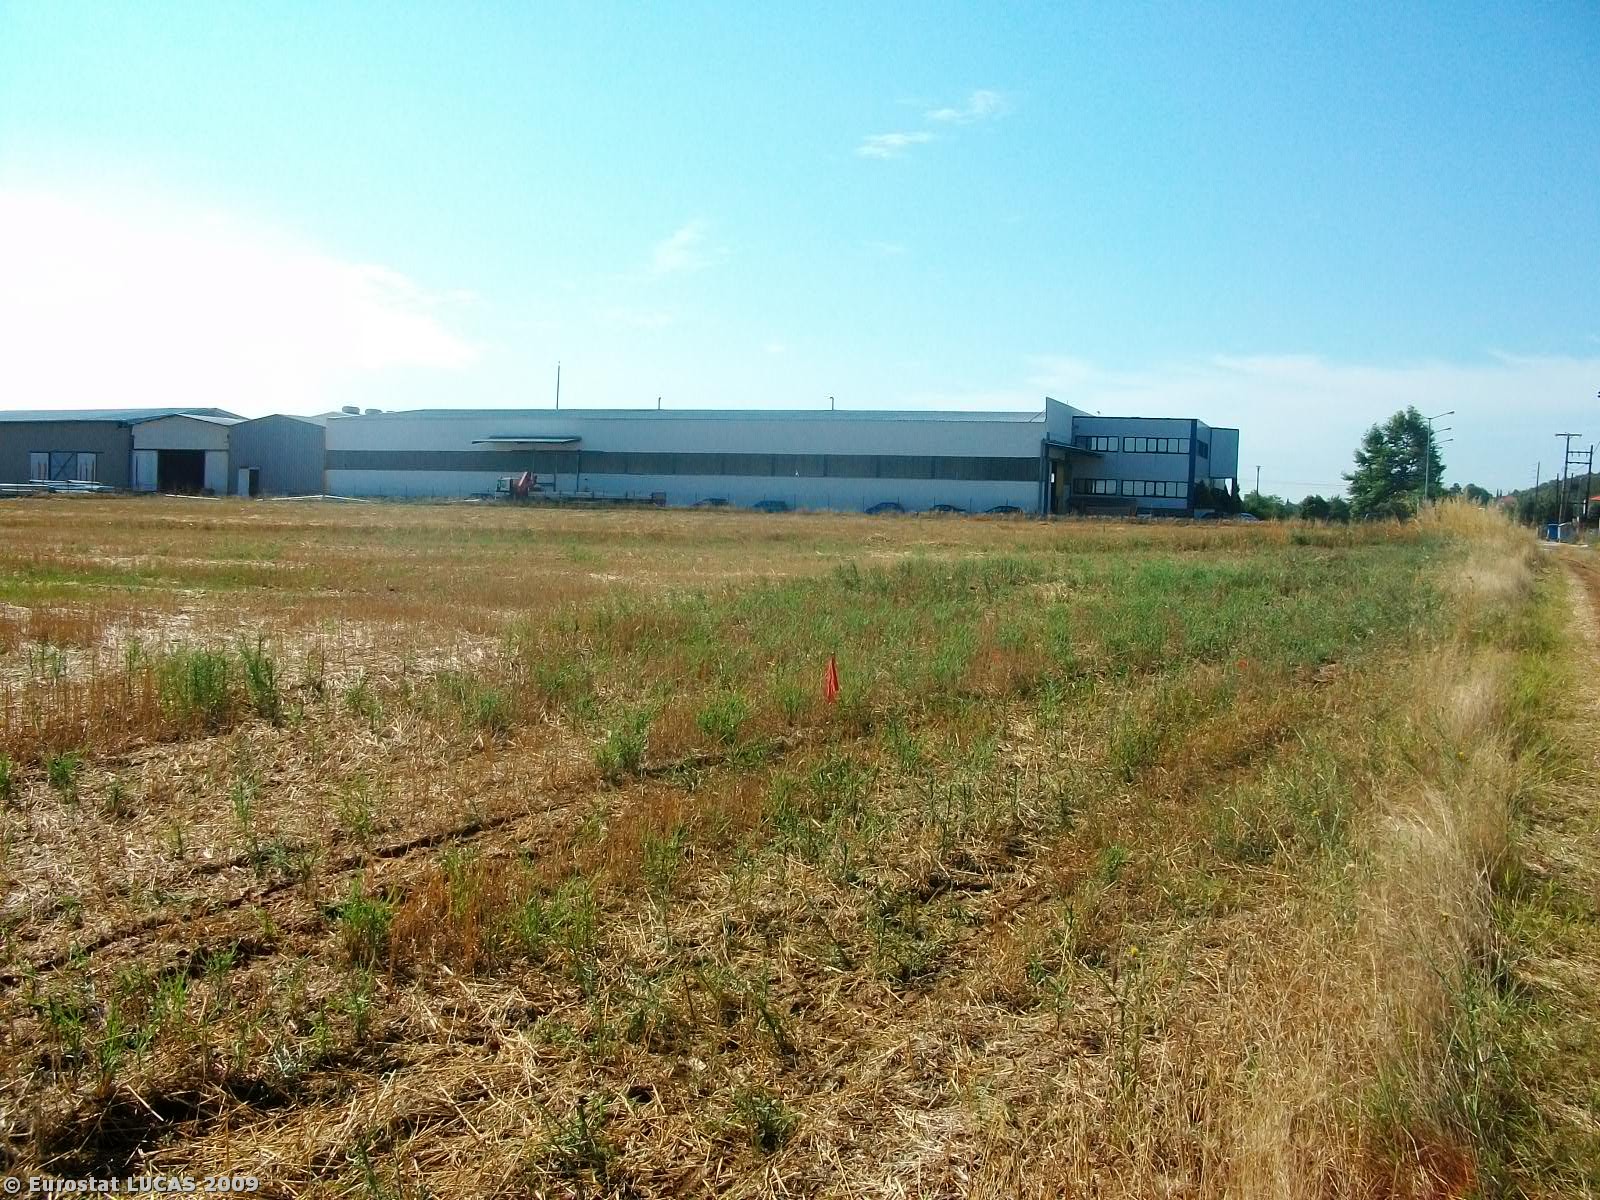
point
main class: Cropland
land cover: Barley
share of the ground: > 75 %
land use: Agriculture (excluding fallow land and kitchen gardens)
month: June
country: GR
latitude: 41.0022
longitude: 22.7660
